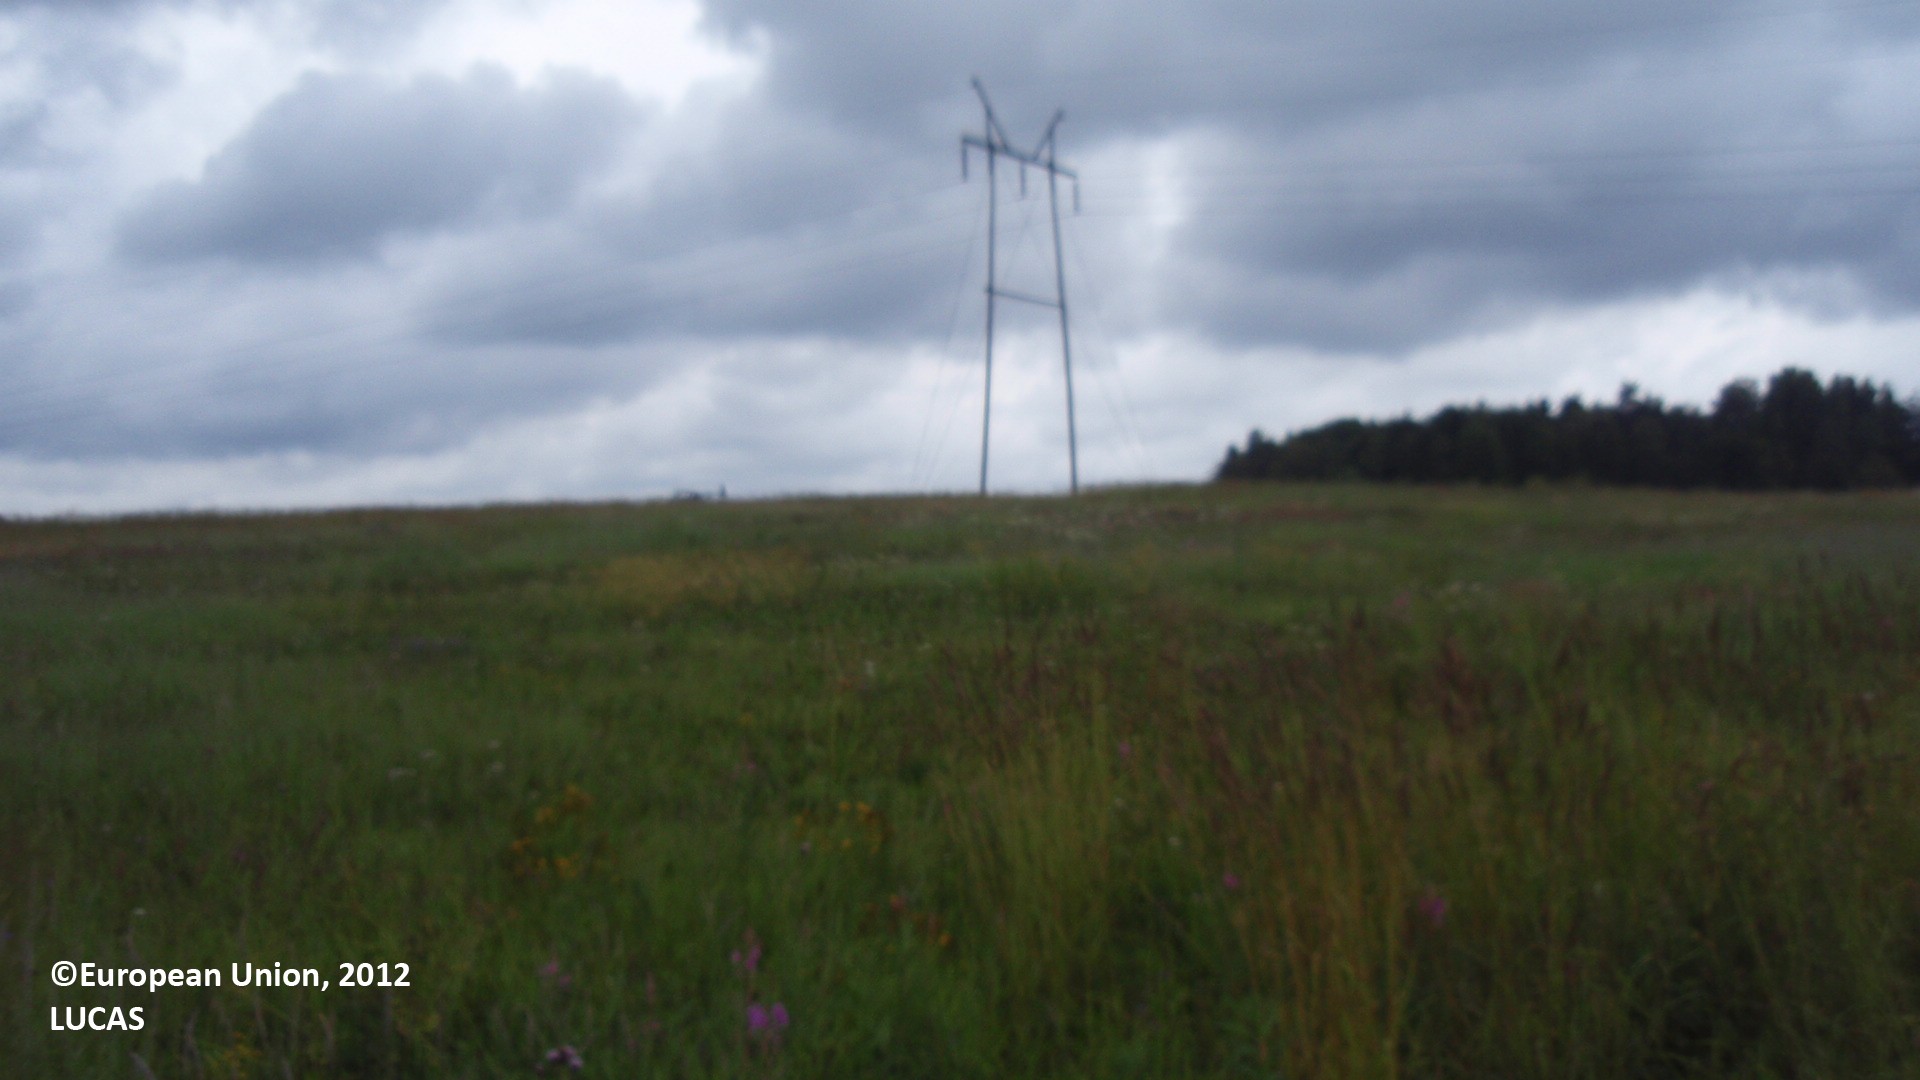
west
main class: Grassland
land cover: Grassland without tree/shrub cover
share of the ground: > 75 %
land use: Fallow land
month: July
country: FI
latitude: 61.0923
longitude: 28.5202
